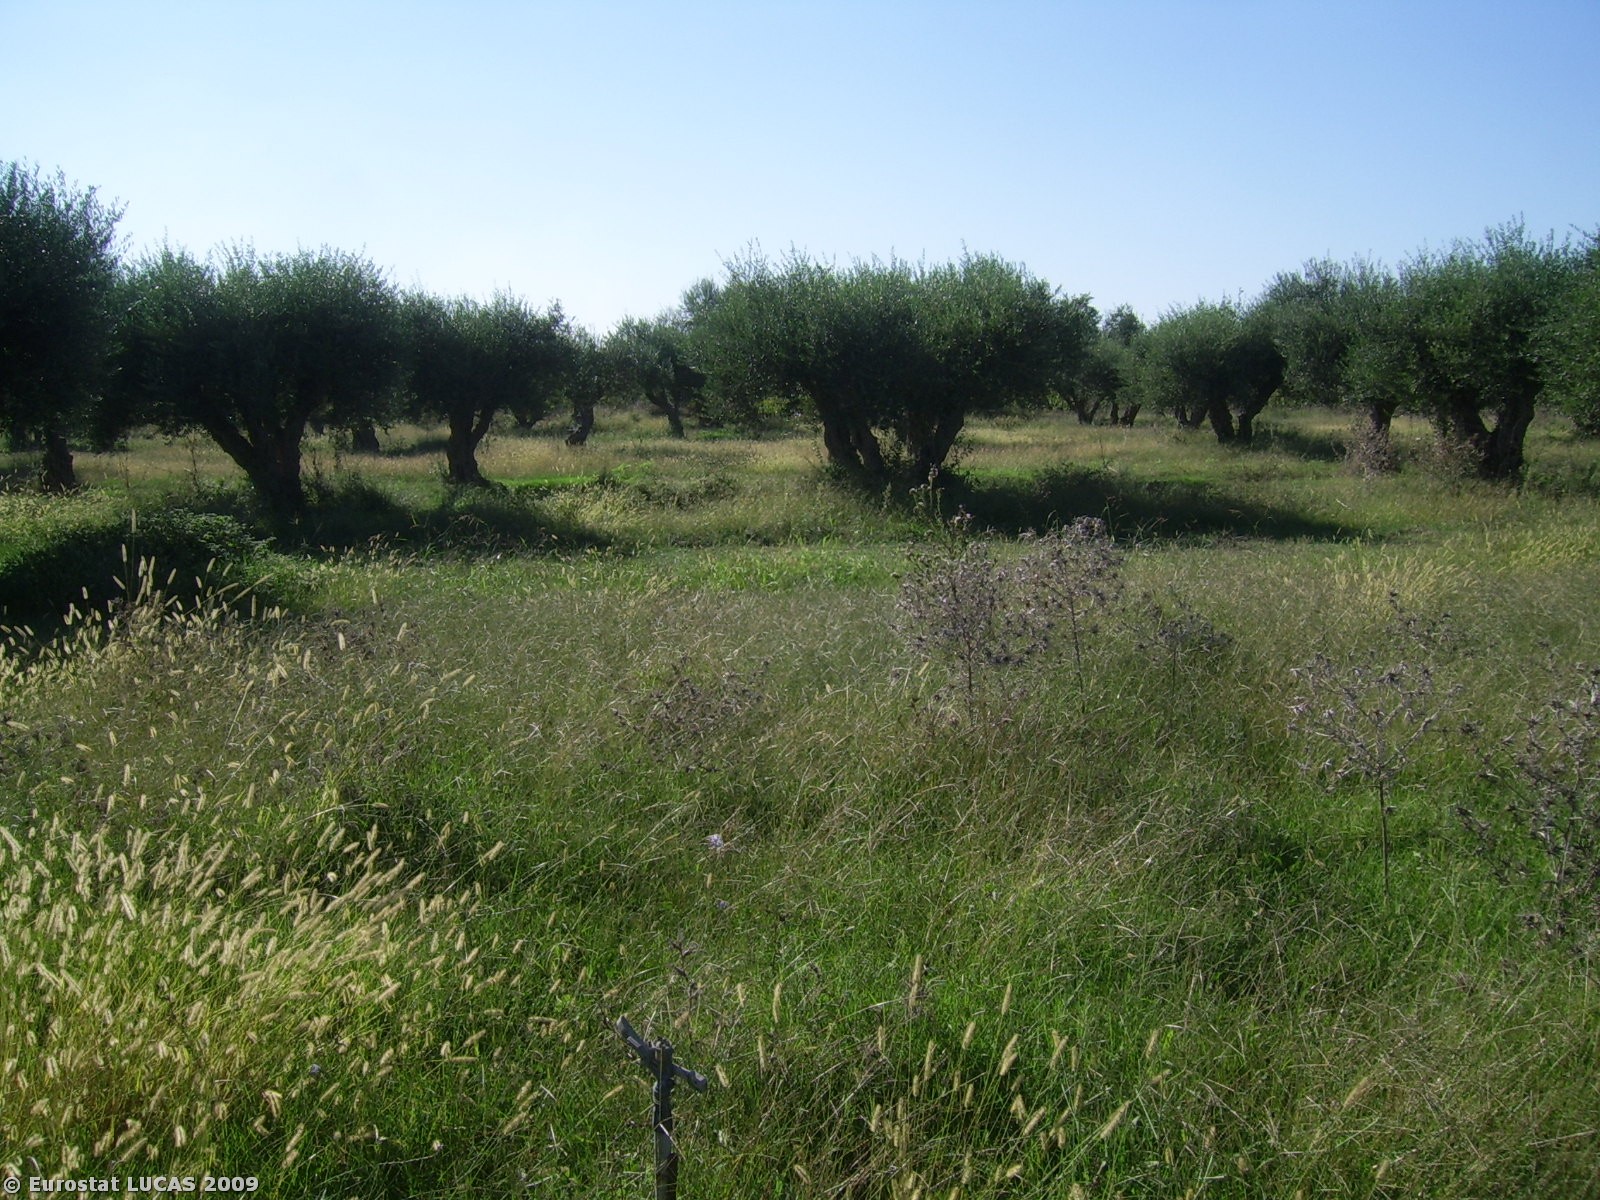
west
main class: Grassland
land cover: Grassland with sparse tree/shrub cover
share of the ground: > 75 %
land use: Unused
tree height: < 5 m
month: October
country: GR
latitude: 37.8565
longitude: 21.3148
